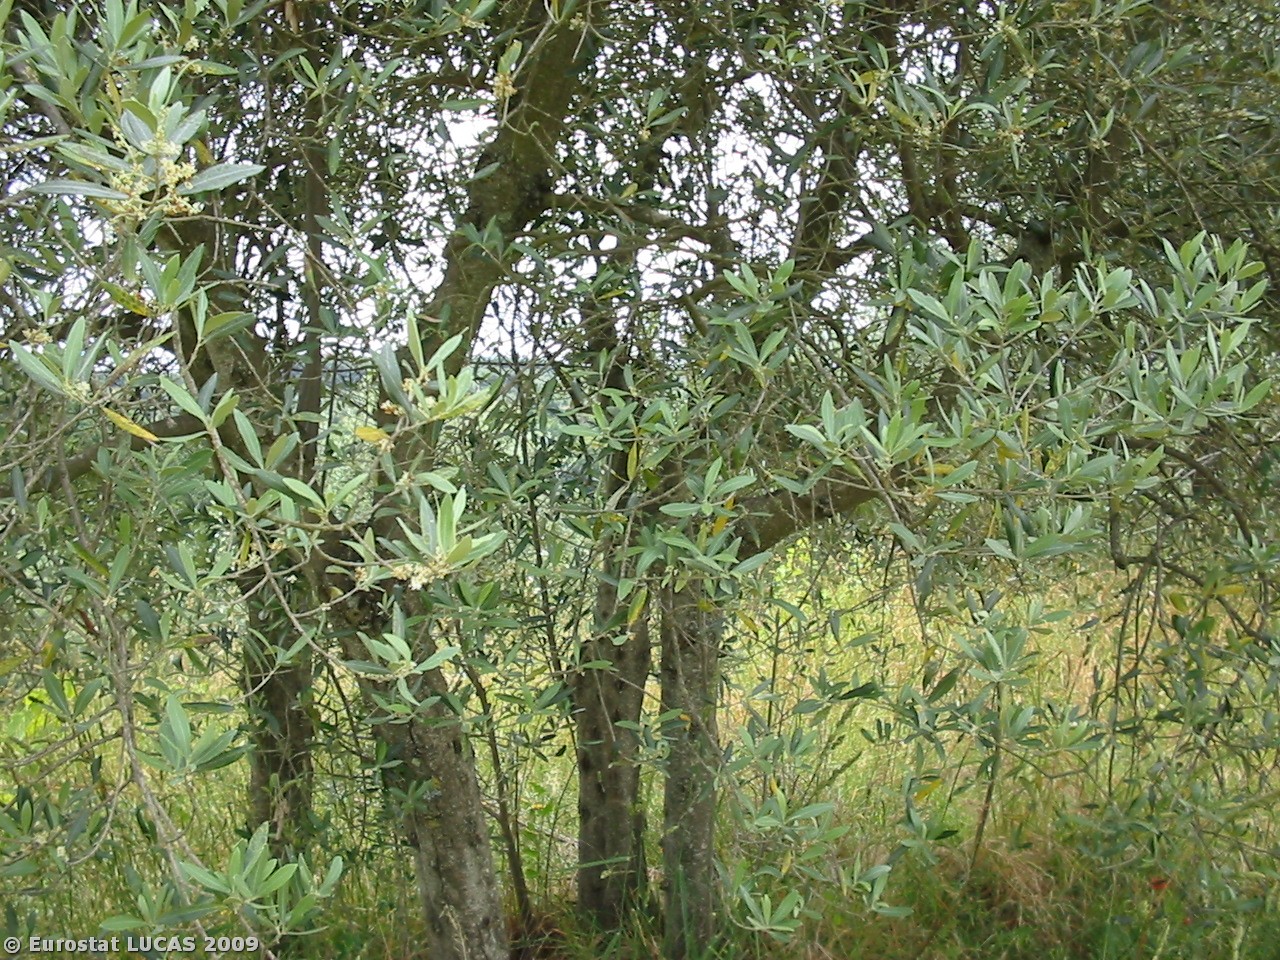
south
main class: Cropland
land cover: Olive groves
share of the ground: 25 - 50 %
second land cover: Spontaneously vegetated surfaces
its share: > 75 %
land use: Agriculture (excluding fallow land and kitchen gardens)
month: June
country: IT
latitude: 42.9596
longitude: 11.9921
